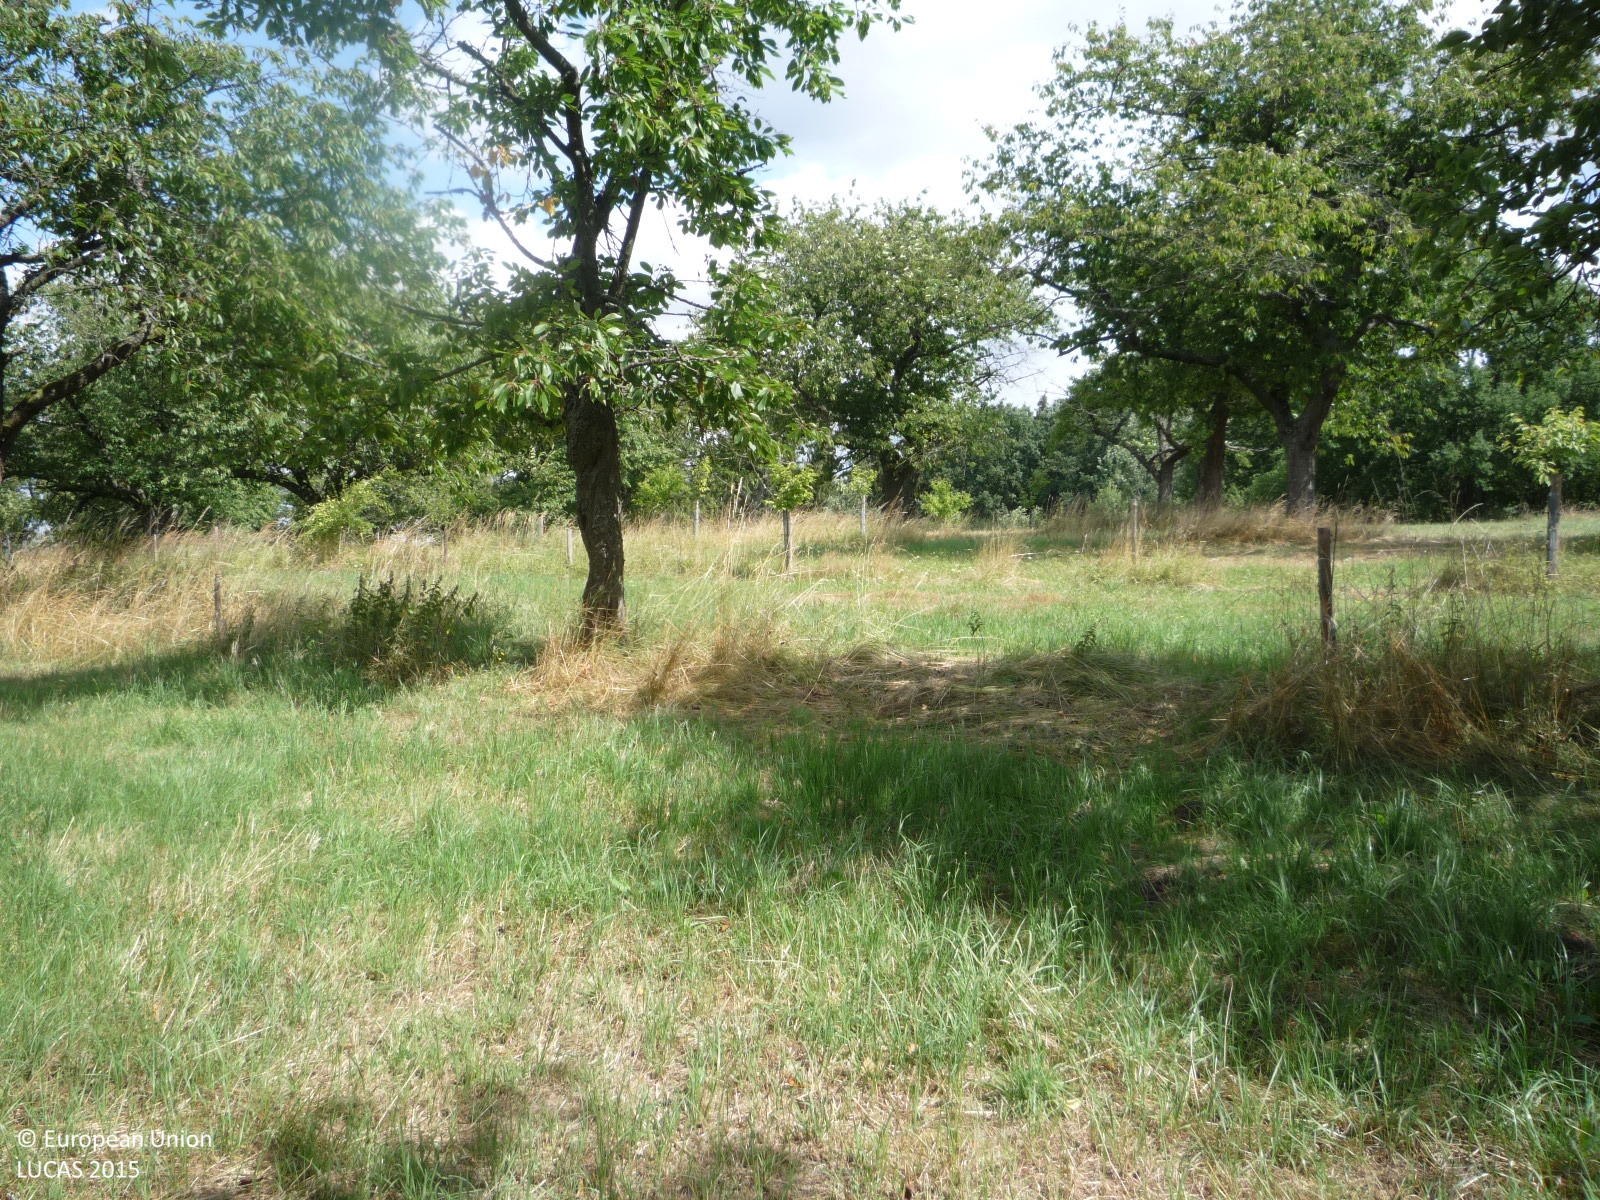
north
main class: Cropland
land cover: Cherry fruit
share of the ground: 50 - 75 %
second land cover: Grassland without tree/shrub cover
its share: 25 - 50 %
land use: Agriculture (excluding fallow land and kitchen gardens)
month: July
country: CZ
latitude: 50.4978
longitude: 15.2054
